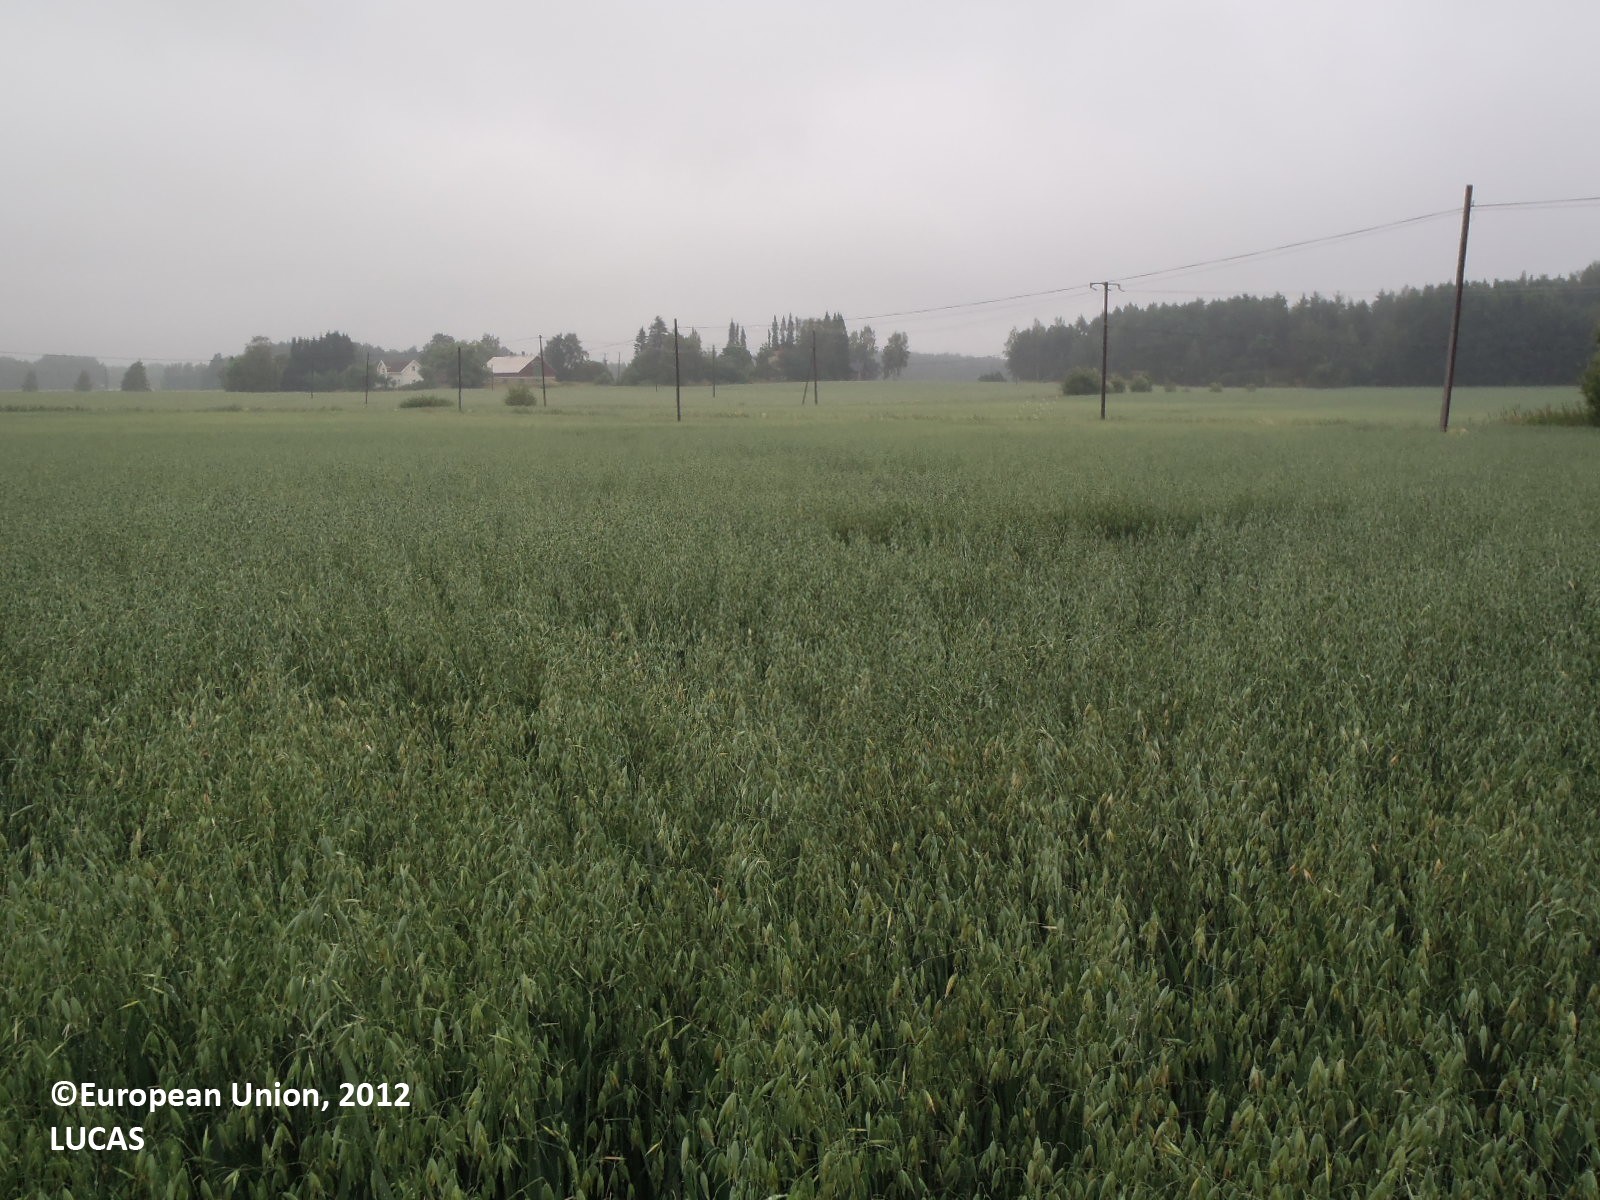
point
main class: Cropland
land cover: Oats
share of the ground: > 75 %
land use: Agriculture (excluding fallow land and kitchen gardens)
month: July
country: FI
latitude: 60.6896
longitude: 21.7605
